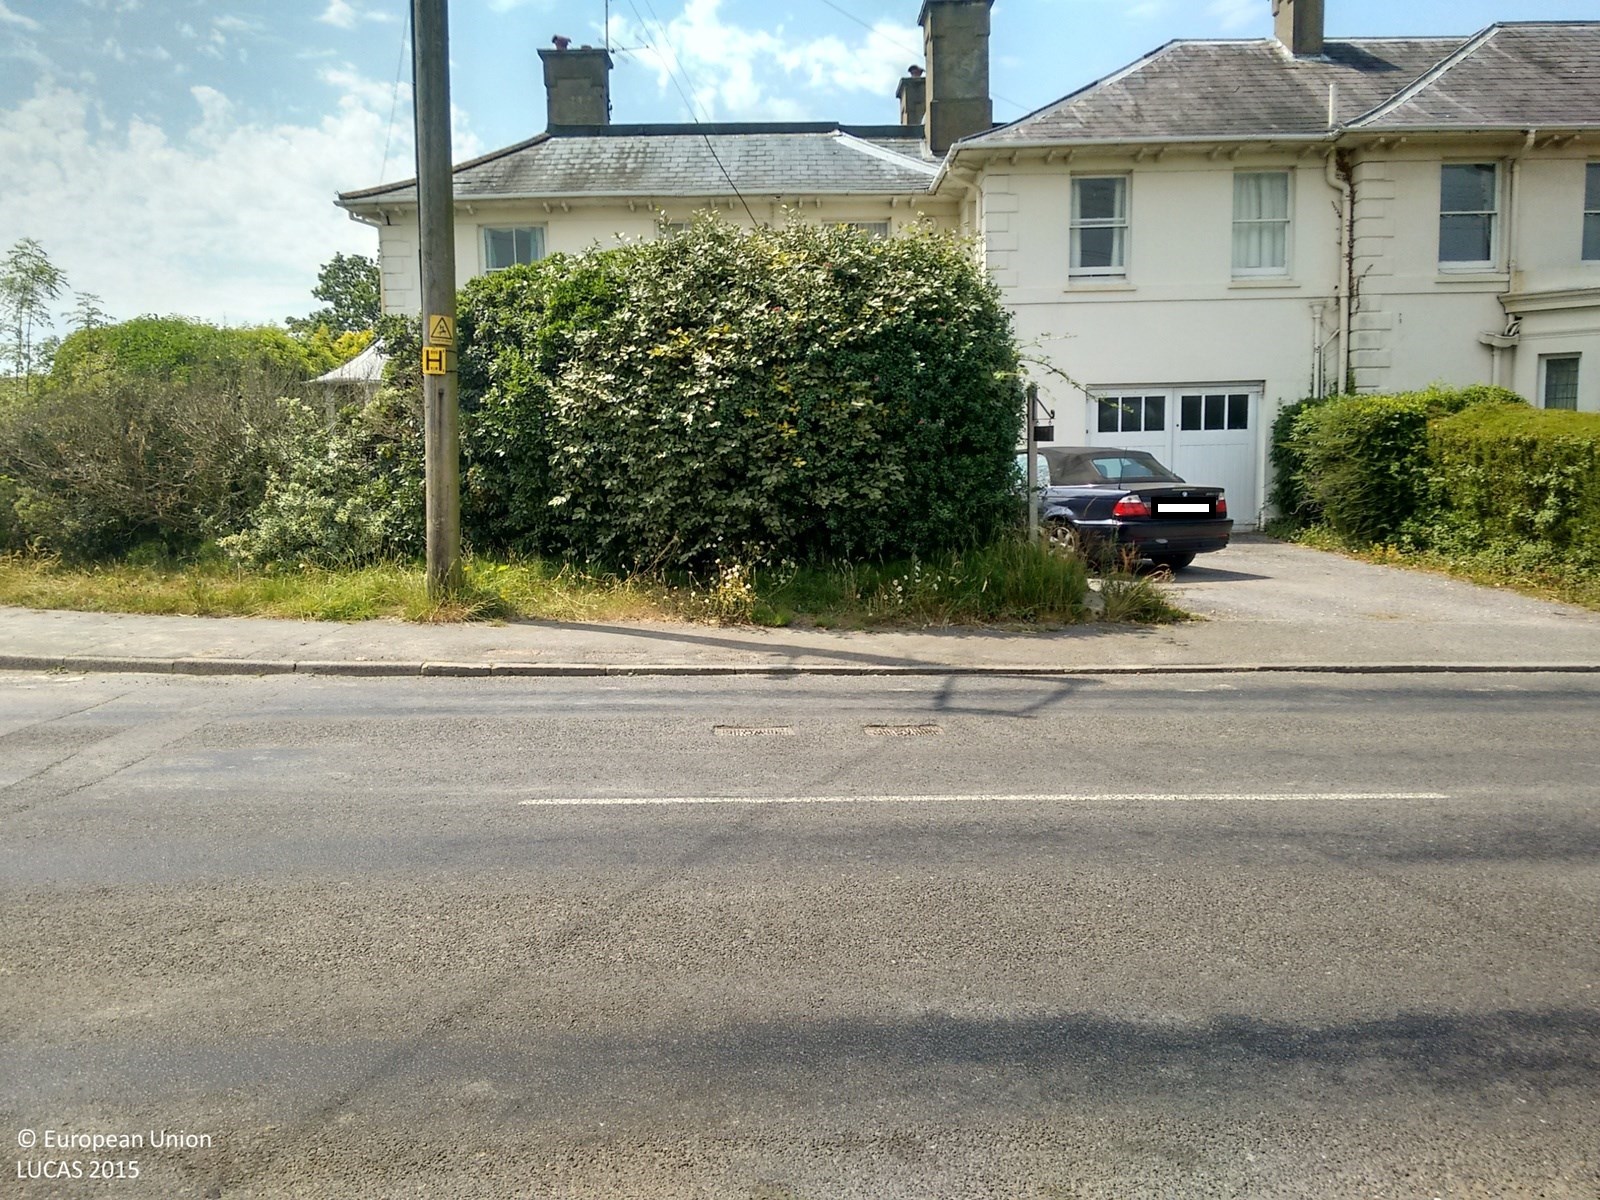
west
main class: Grassland
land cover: Grassland with sparse tree/shrub cover
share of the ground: > 75 %
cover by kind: herbaceous plants 85 %, shrubs 10 %, broadleaved forest trees 5 %
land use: Residential
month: July
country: GB
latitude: 50.9466
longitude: -0.1256
